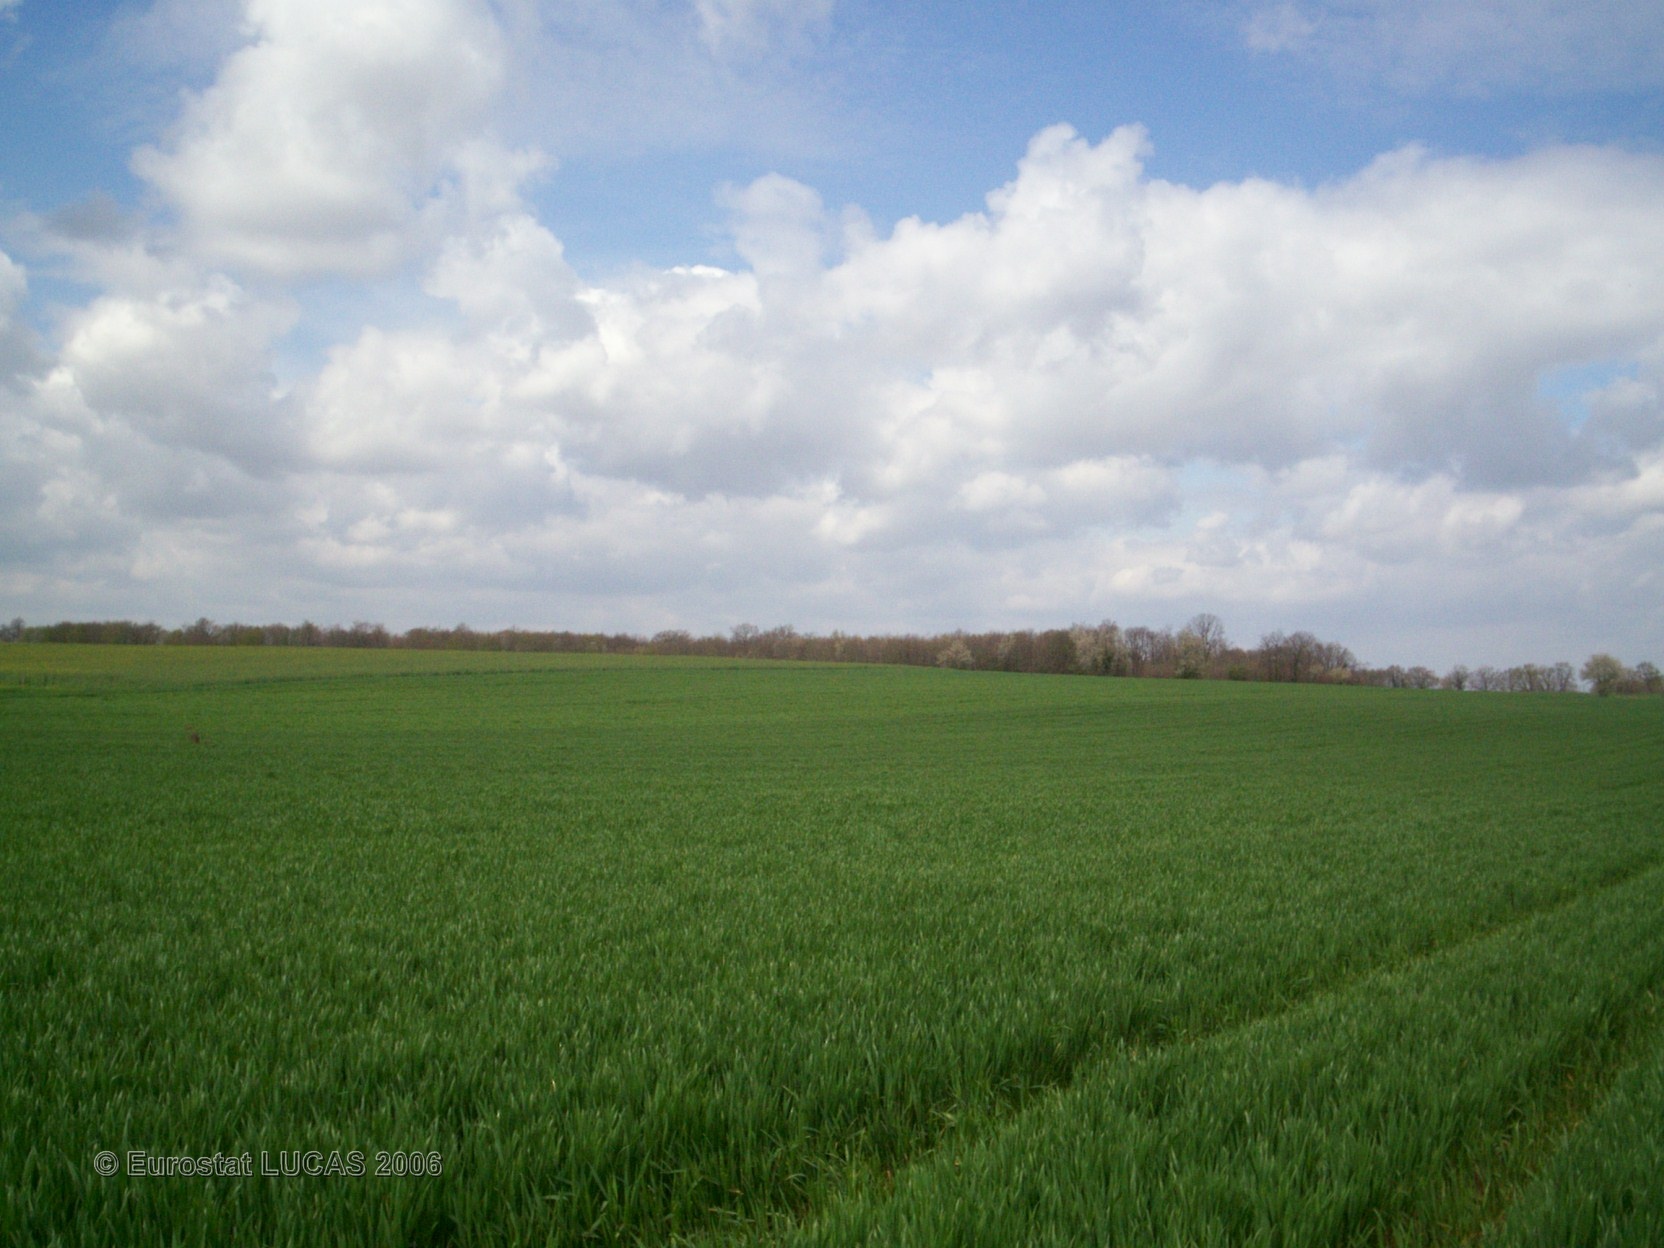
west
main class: Cropland
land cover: Common wheat
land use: Agriculture (excluding fallow land and kitchen gardens)
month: April
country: FR
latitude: 46.1066
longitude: 0.4751
